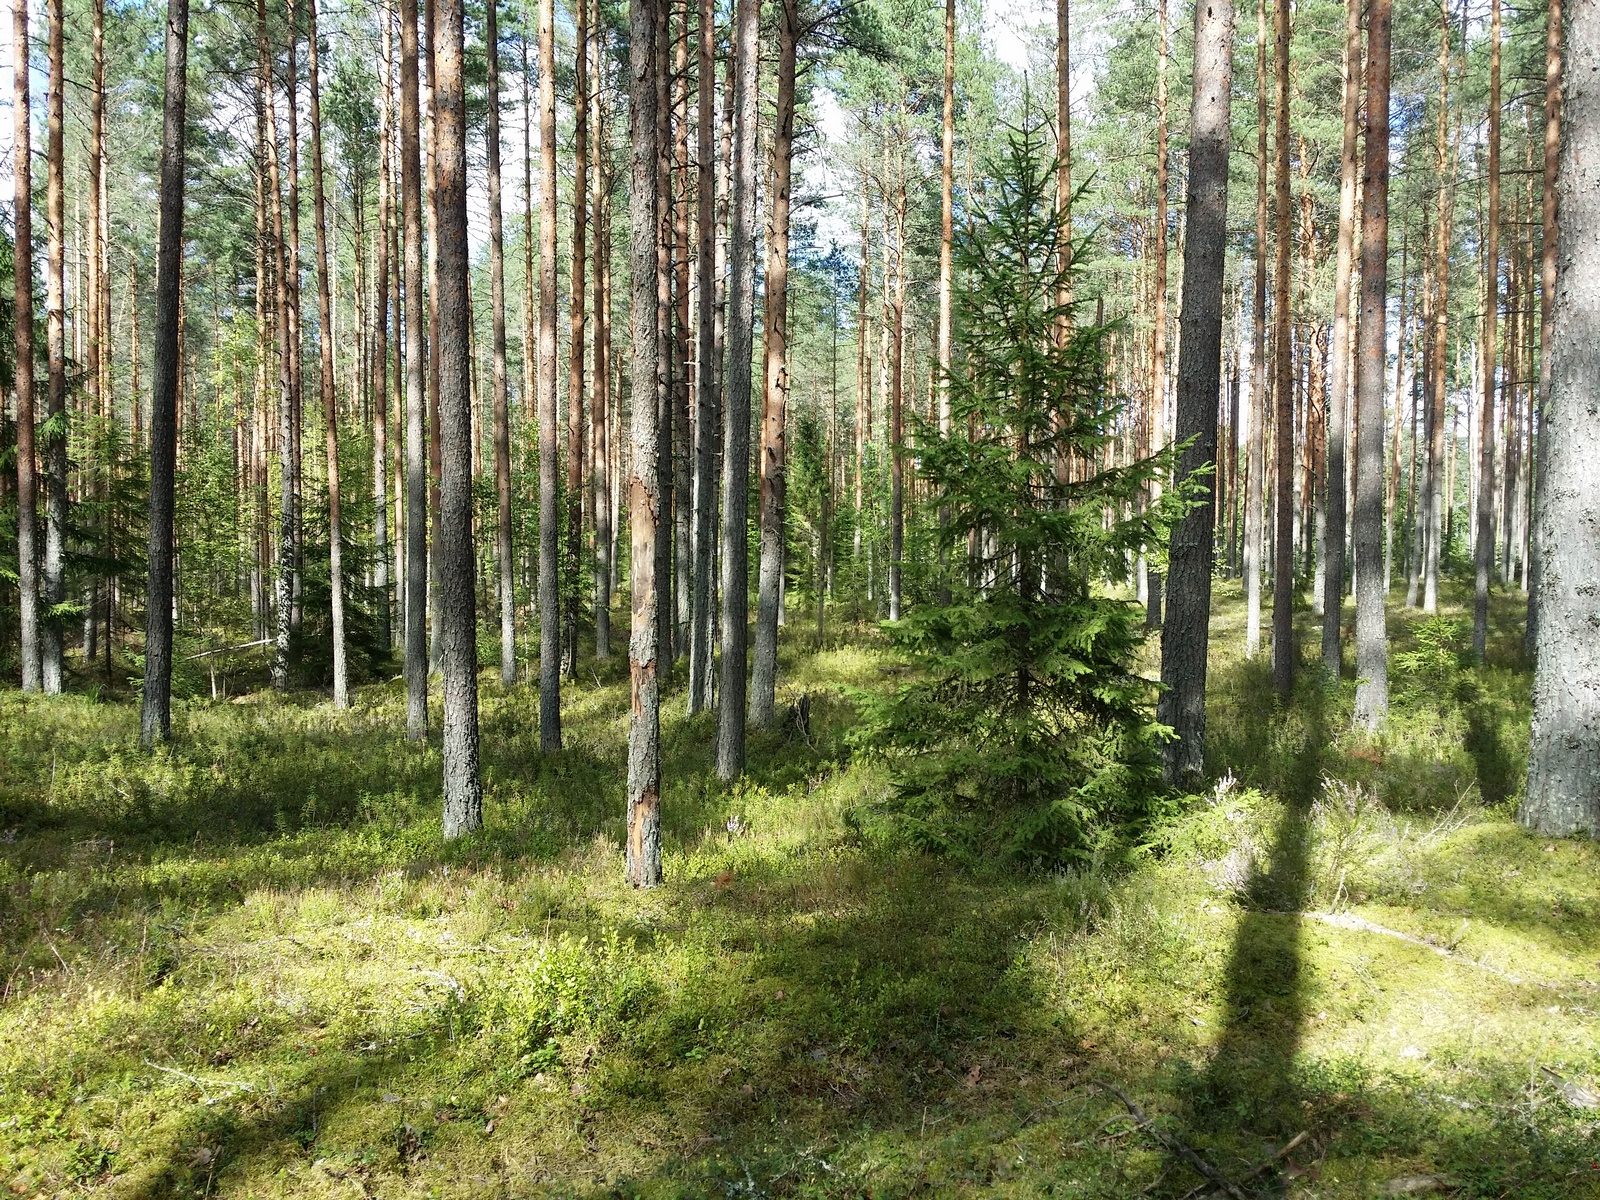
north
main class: Woodland
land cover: Pine dominated coniferous woodland
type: hemiboreal forest and nemoral coniferous forest and mixed broadleaved-coniferous forest
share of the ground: 50 - 75 %
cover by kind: coniferous forest trees 70 %, lichens and mosses 25 %, shrubs 5 %
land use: Forestry
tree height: > 5 m
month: August
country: LV
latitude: 57.3119
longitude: 27.6622
